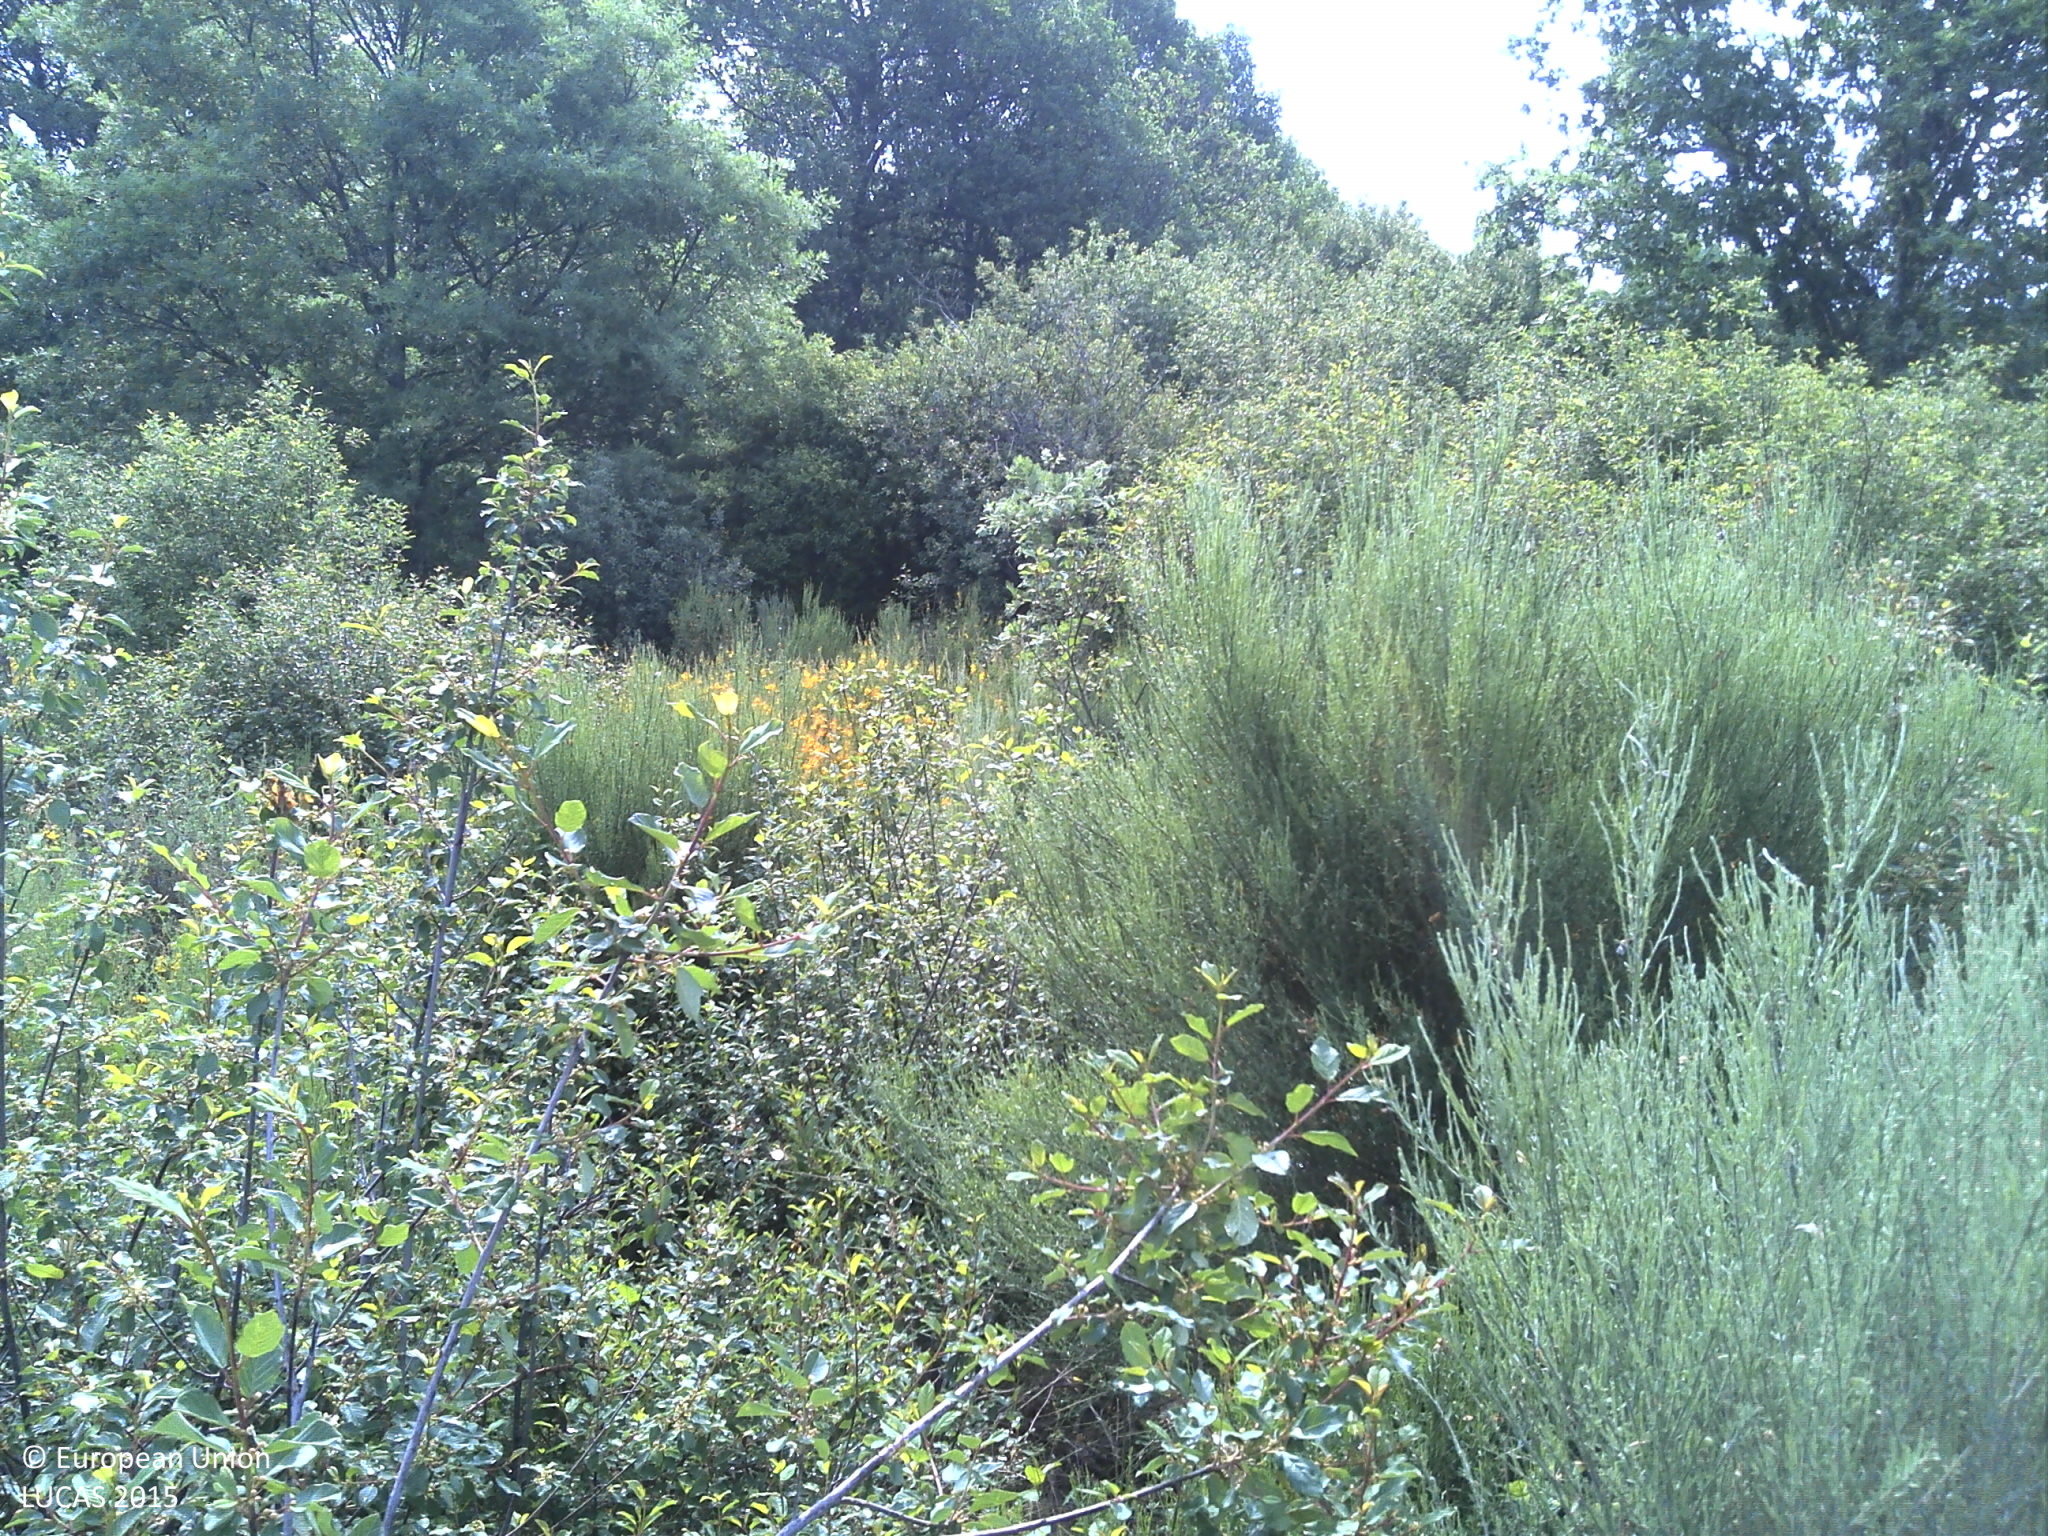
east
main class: Shrubland
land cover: Shrubland with sparse tree cover
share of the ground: > 75 %
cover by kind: shrubs 95 %, broadleaved forest trees 5 %
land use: Semi-natural and natural areas not in use
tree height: > 5 m
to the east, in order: Shrubland with sparse tree cover; Rivers and streams; Broadleaved woodland; Dry stone walls; Spontaneously vegetated surfaces; Shrubland without tree cover; Dry stone walls; Spontaneously vegetated surfaces; Shrubland with sparse tree cover; Dry stone walls; Tracks; Dry stone walls; Grassland with sparse tree/shrub cover; Dry stone walls; Shrubland with sparse tree cover
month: June
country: PT
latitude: 41.4409
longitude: -7.5417
